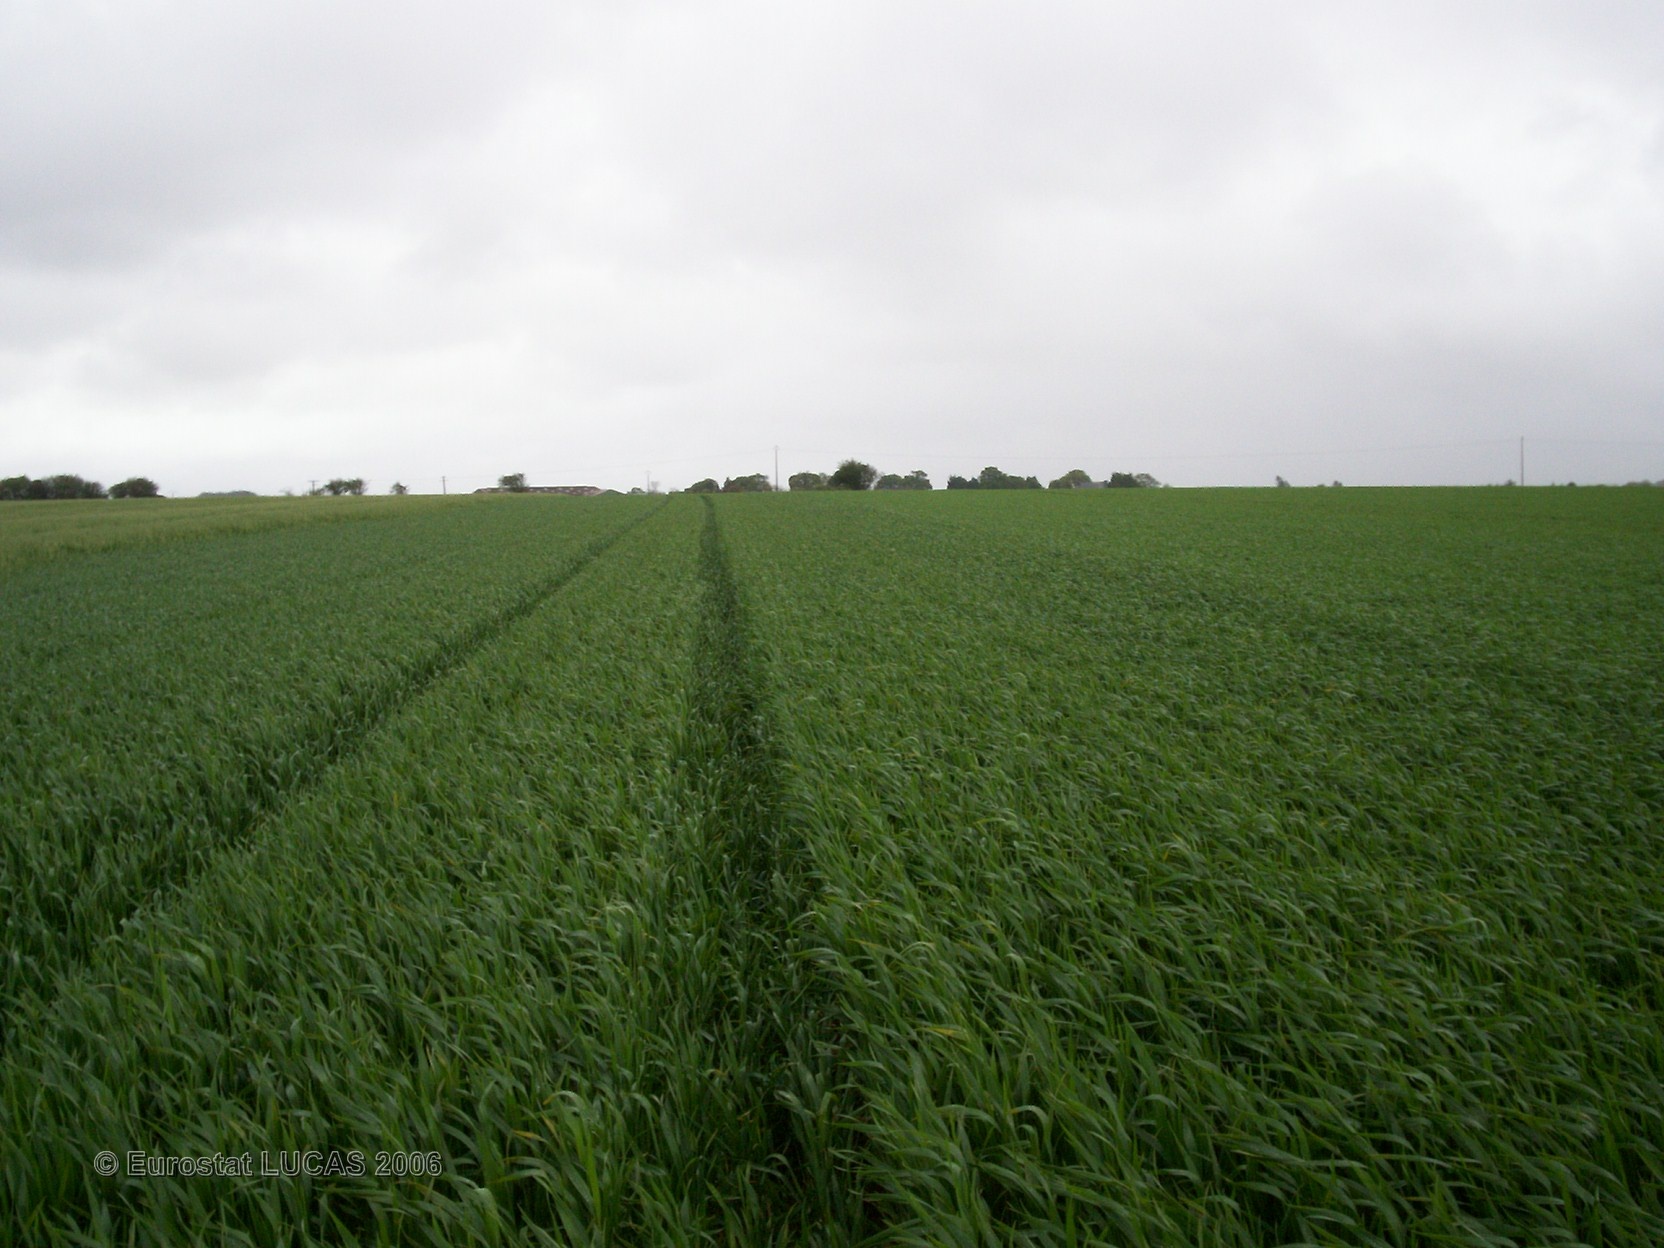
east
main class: Cropland
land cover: Common wheat
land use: Agriculture (excluding fallow land and kitchen gardens)
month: May
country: FR
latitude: 48.3203
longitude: -3.6343
